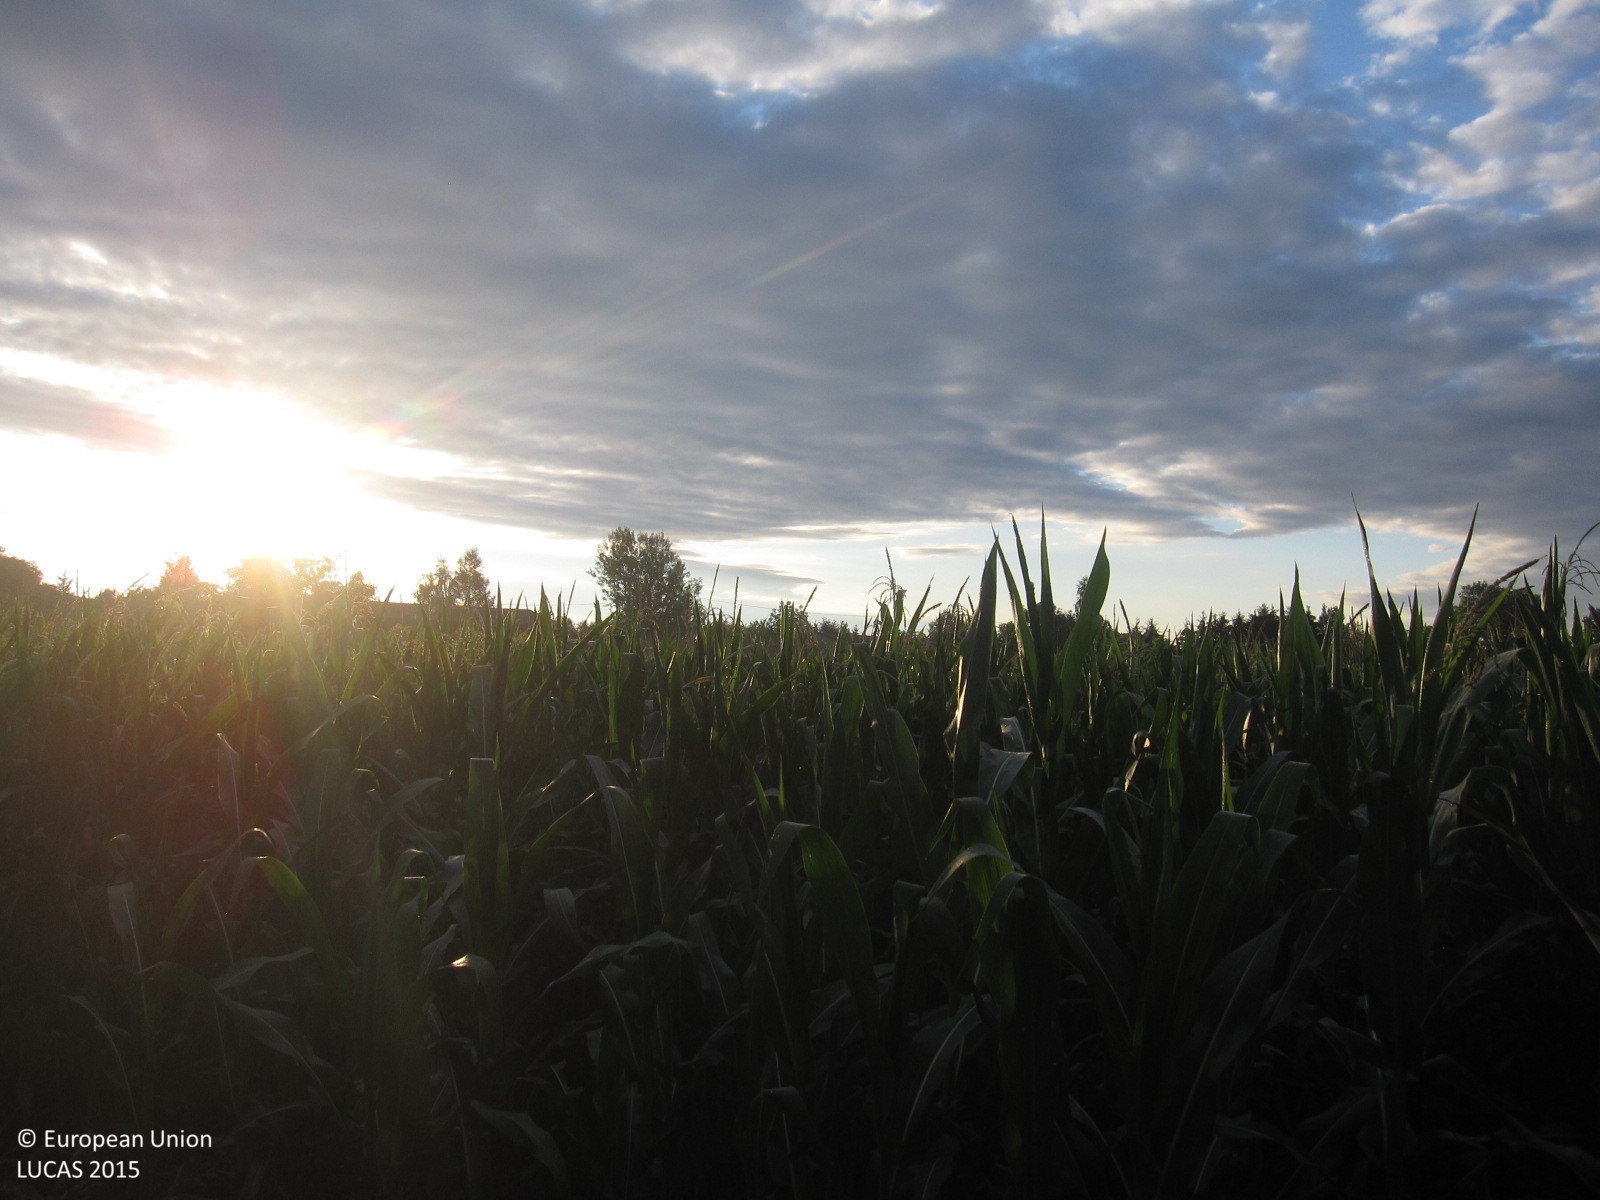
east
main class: Cropland
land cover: Maize
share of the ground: > 75 %
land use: Agriculture (excluding fallow land and kitchen gardens)
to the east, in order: Maize; Grassland without tree/shrub cover; Electric lines; Paved roads, cycling and walking lanes; Grassland without tree/shrub cover; Fences; Grassland without tree/shrub cover; Spruce dominated coniferous woodland; Fences; Grassland without tree/shrub cover; Broadleaved woodland; Grassland without tree/shrub cover
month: July
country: DE
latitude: 51.0807
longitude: 12.1837
